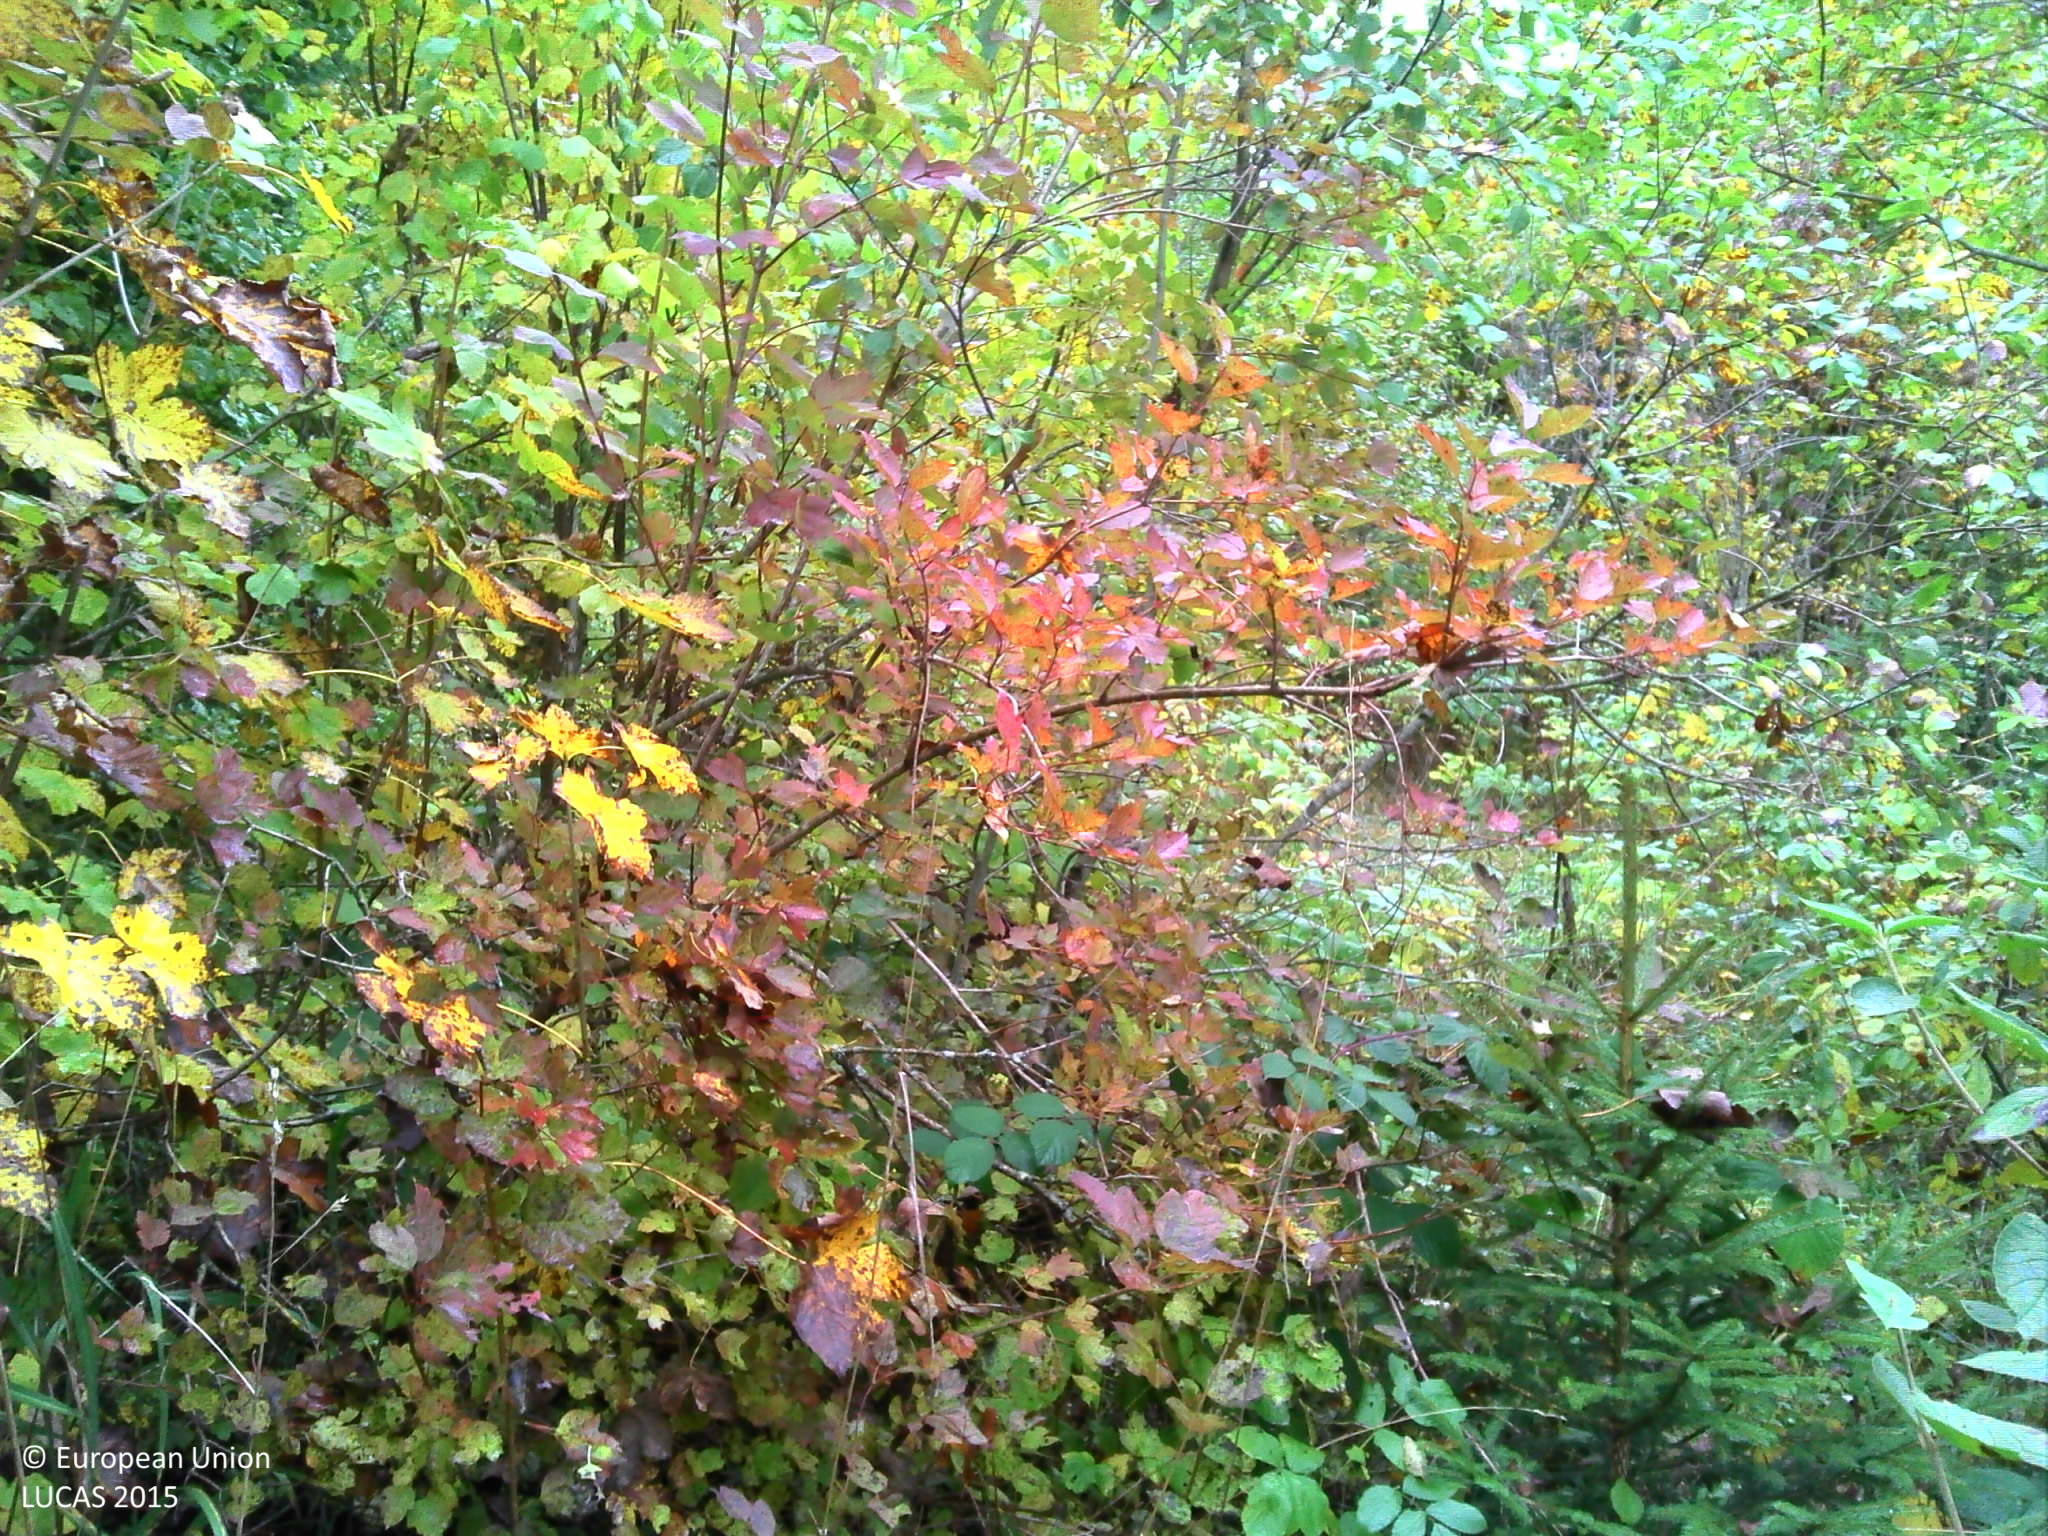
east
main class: Woodland
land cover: Spruce dominated mixed woodland
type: hemiboreal forest and nemoral coniferous forest and mixed broadleaved-coniferous forest
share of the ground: > 75 %
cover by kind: coniferous forest trees 40 %, broadleaved forest trees 40 %, shrubs 20 %
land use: Semi-natural and natural areas not in use
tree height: < 5 m
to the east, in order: Spruce dominated mixed woodland; Broadleaved woodland; Spruce dominated mixed woodland; Dry stone walls; Spruce dominated mixed woodland; Spruce dominated coniferous woodland; Dry stone walls; Broadleaved woodland
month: October
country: FR
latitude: 46.8493
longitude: 6.3960
